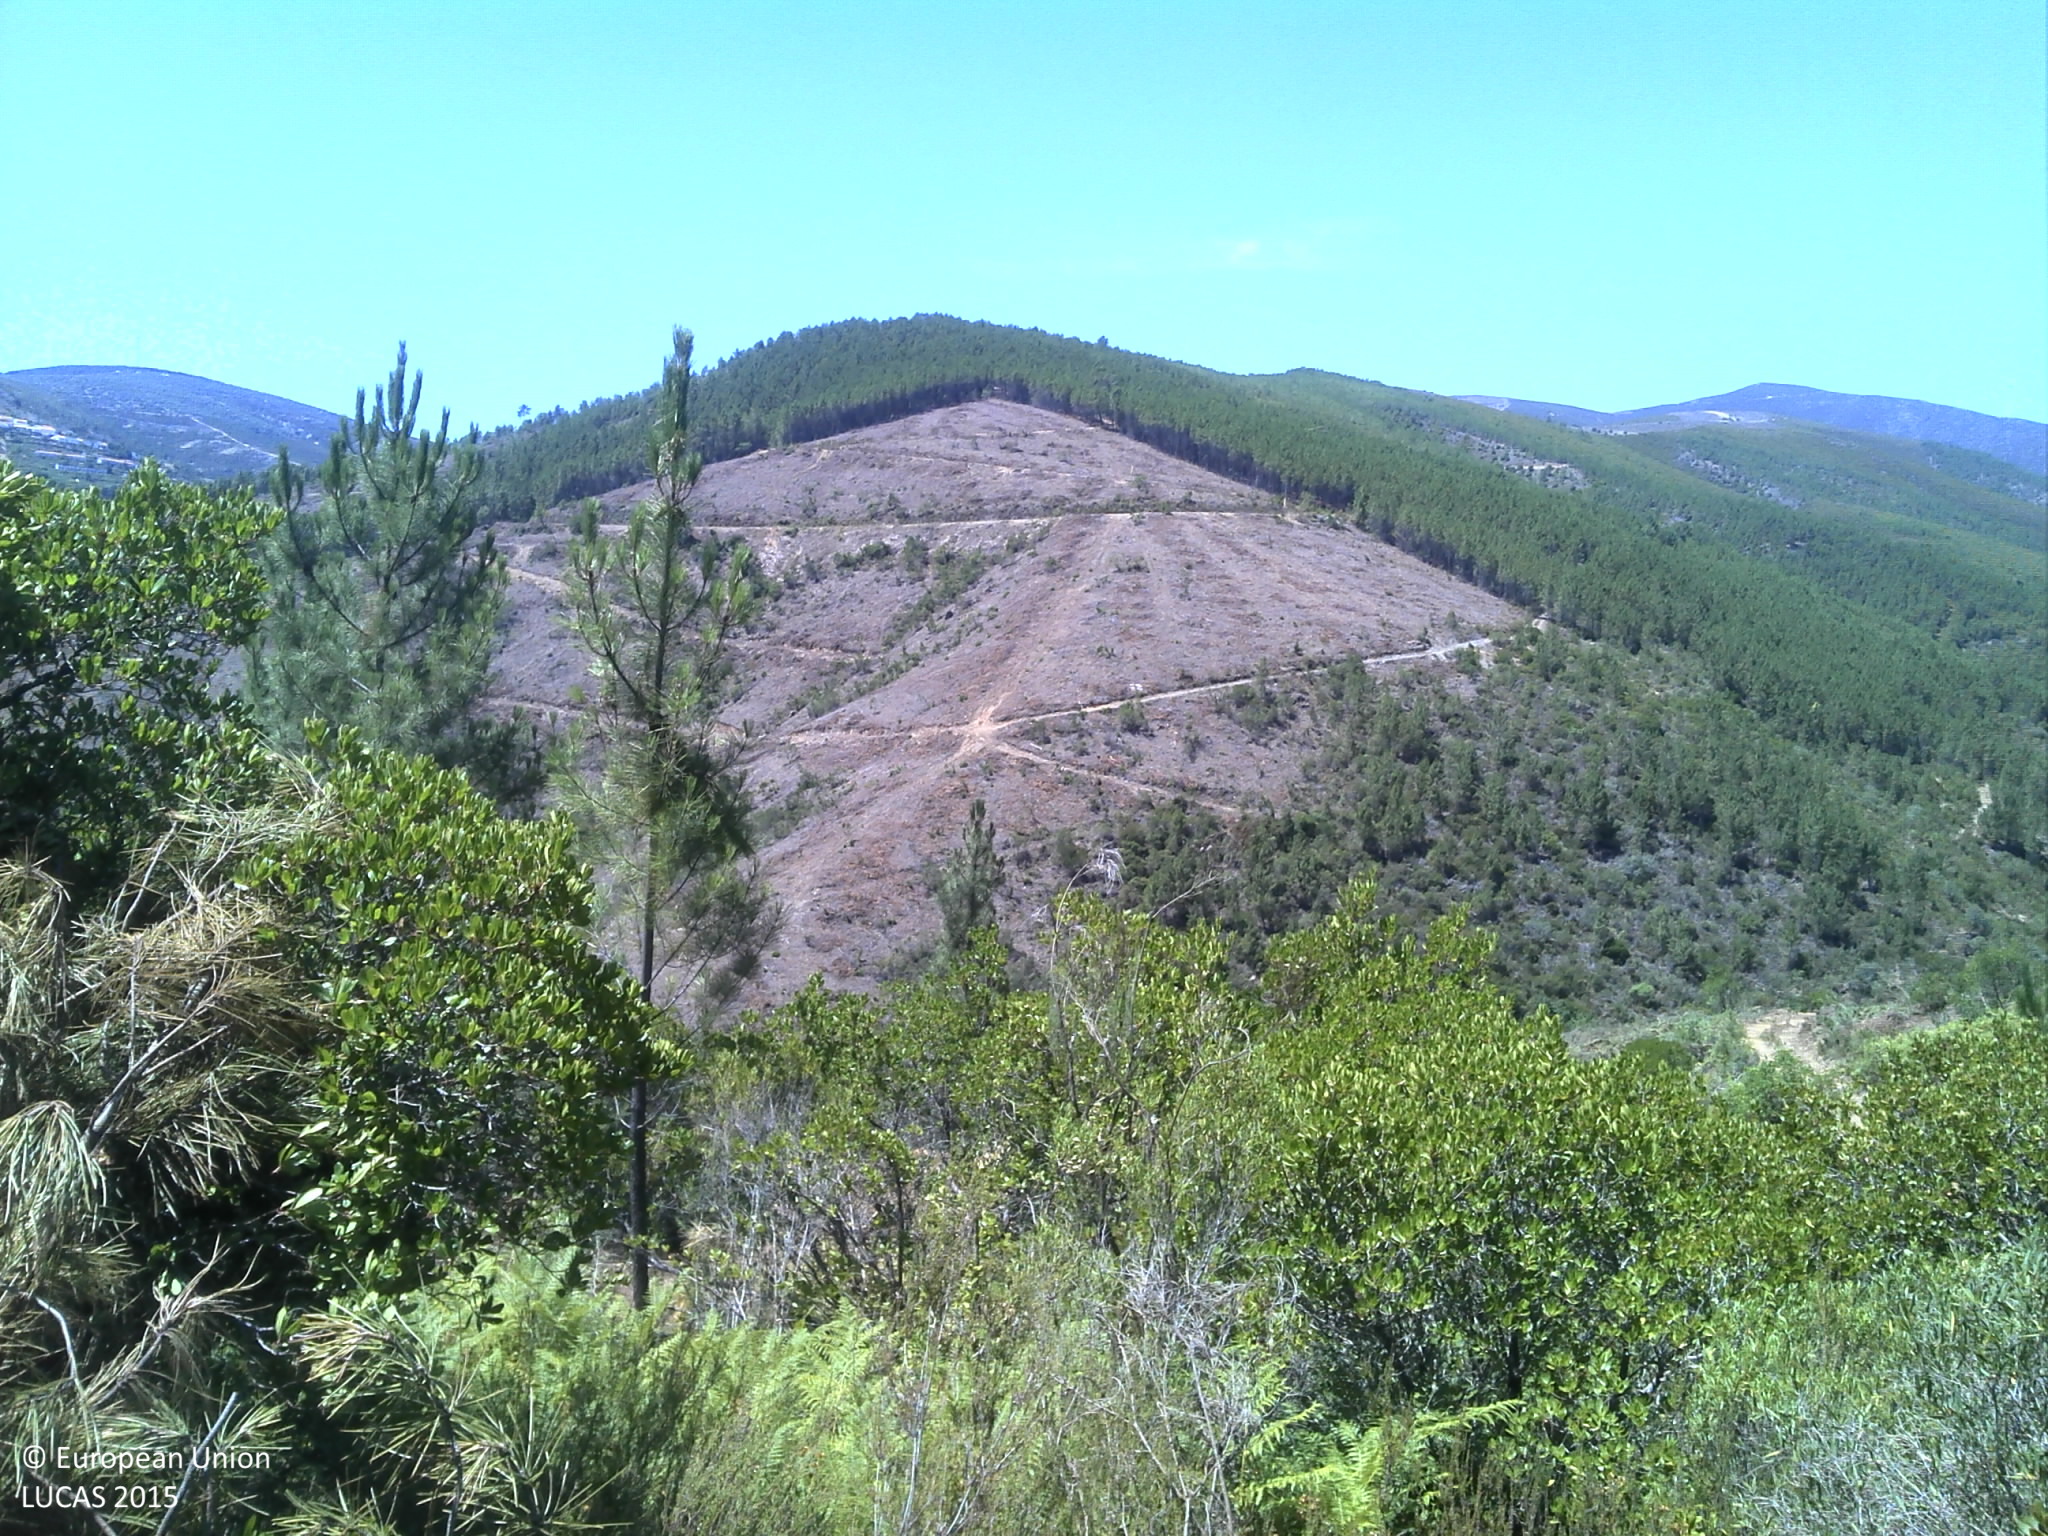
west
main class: Shrubland
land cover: Shrubland without tree cover
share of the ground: 50 - 75 %
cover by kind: shrubs 70 %, herbaceous plants 10 %, unconsolidated bare surface 10 %
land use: Forestry
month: July
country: PT
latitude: 40.1870
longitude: -7.7415
